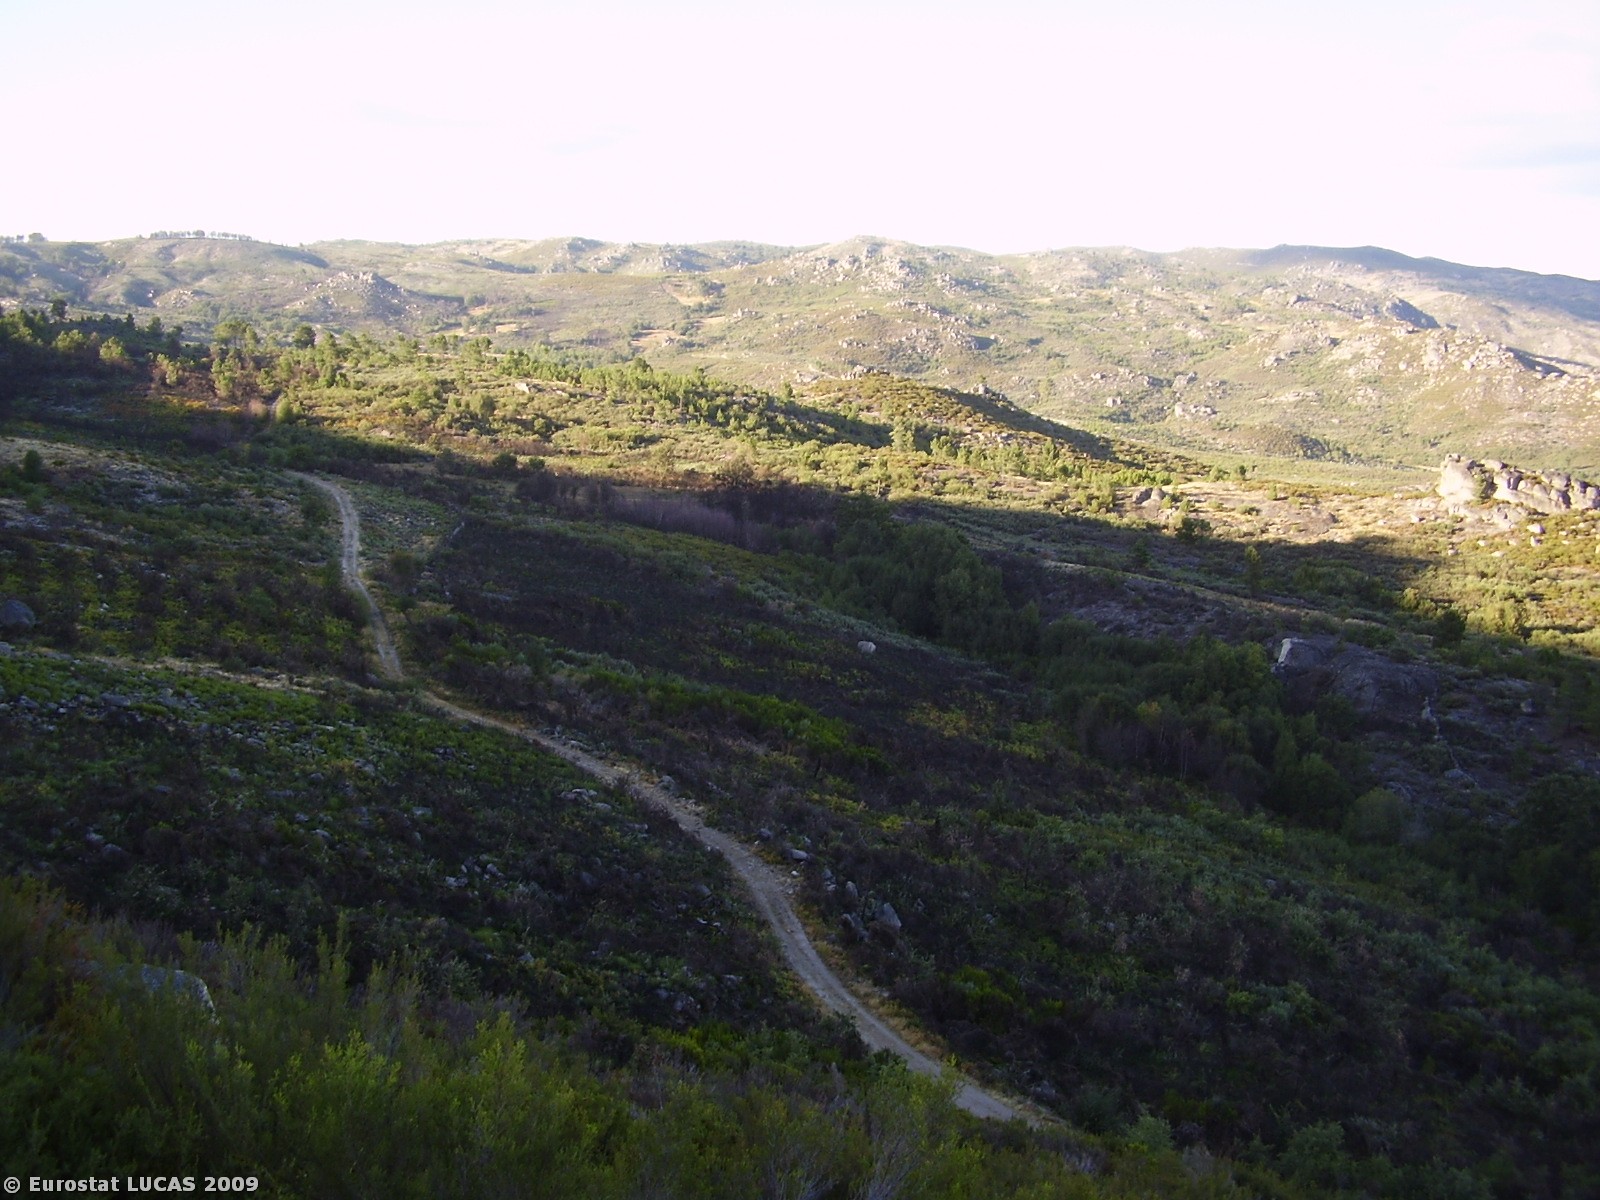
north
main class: Shrubland
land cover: Shrubland without tree cover
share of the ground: > 75 %
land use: Fallow land
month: September
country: PT
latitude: 41.7563
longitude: -7.6341
